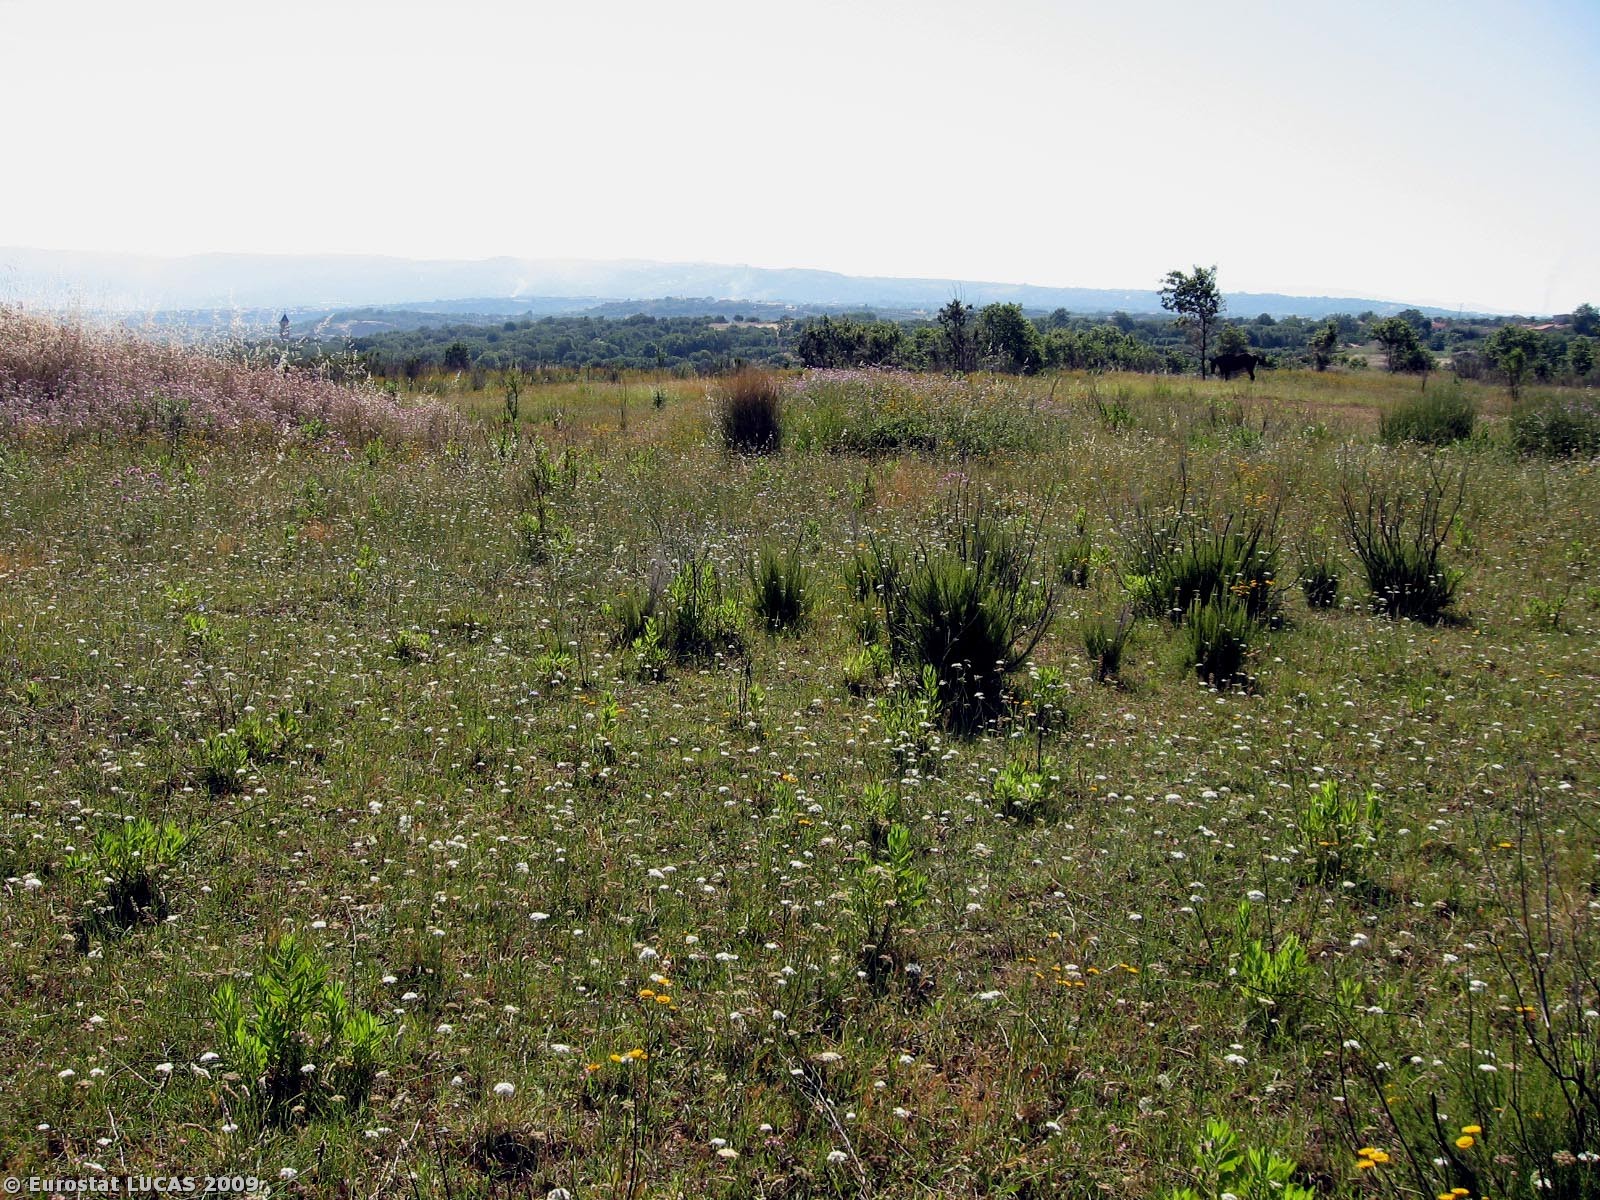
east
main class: Grassland
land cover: Grassland without tree/shrub cover
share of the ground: 50 - 75 %
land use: Fallow land
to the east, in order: Grassland without tree/shrub cover; Shrubland without tree cover
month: June
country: IT
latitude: 38.6867
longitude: 15.9789
